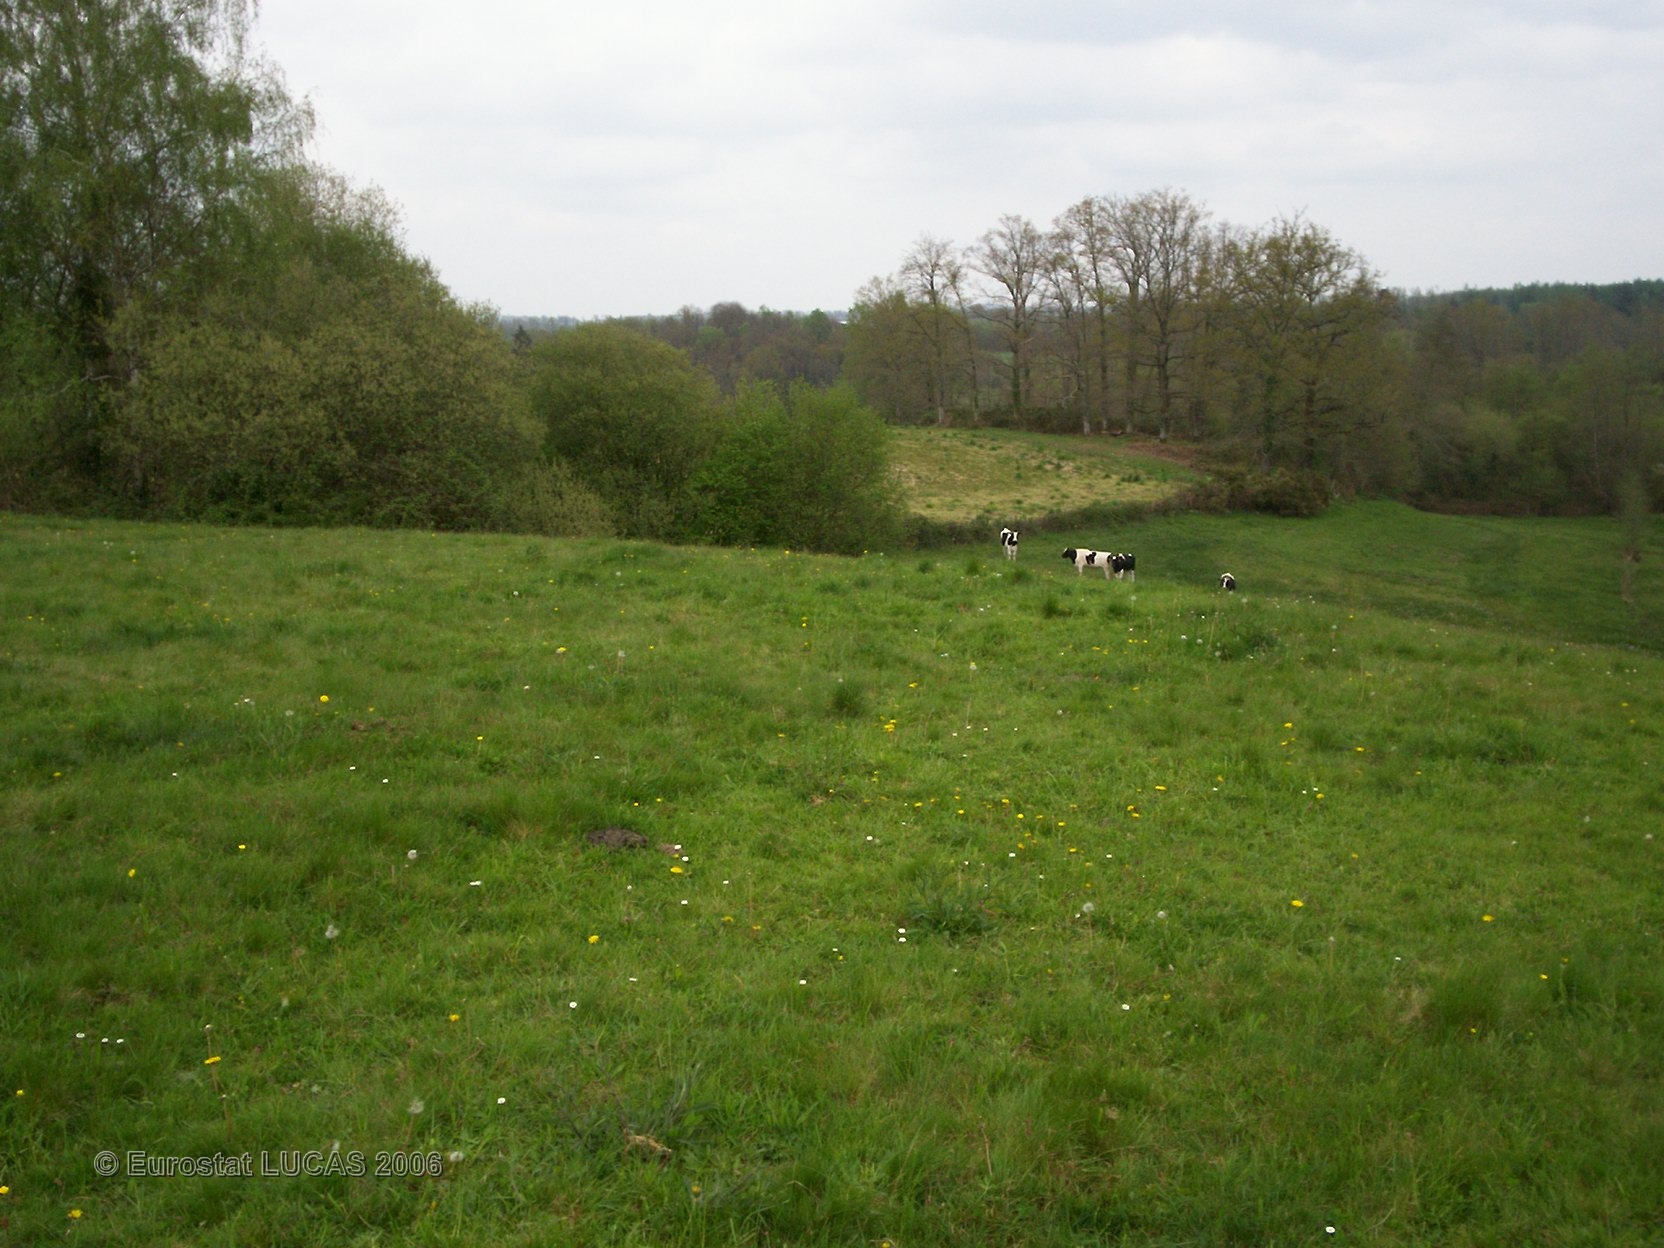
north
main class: Grassland
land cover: Grassland without tree/shrub cover
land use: Agriculture (excluding fallow land and kitchen gardens)
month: April
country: FR
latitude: 45.5913
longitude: 0.7980
